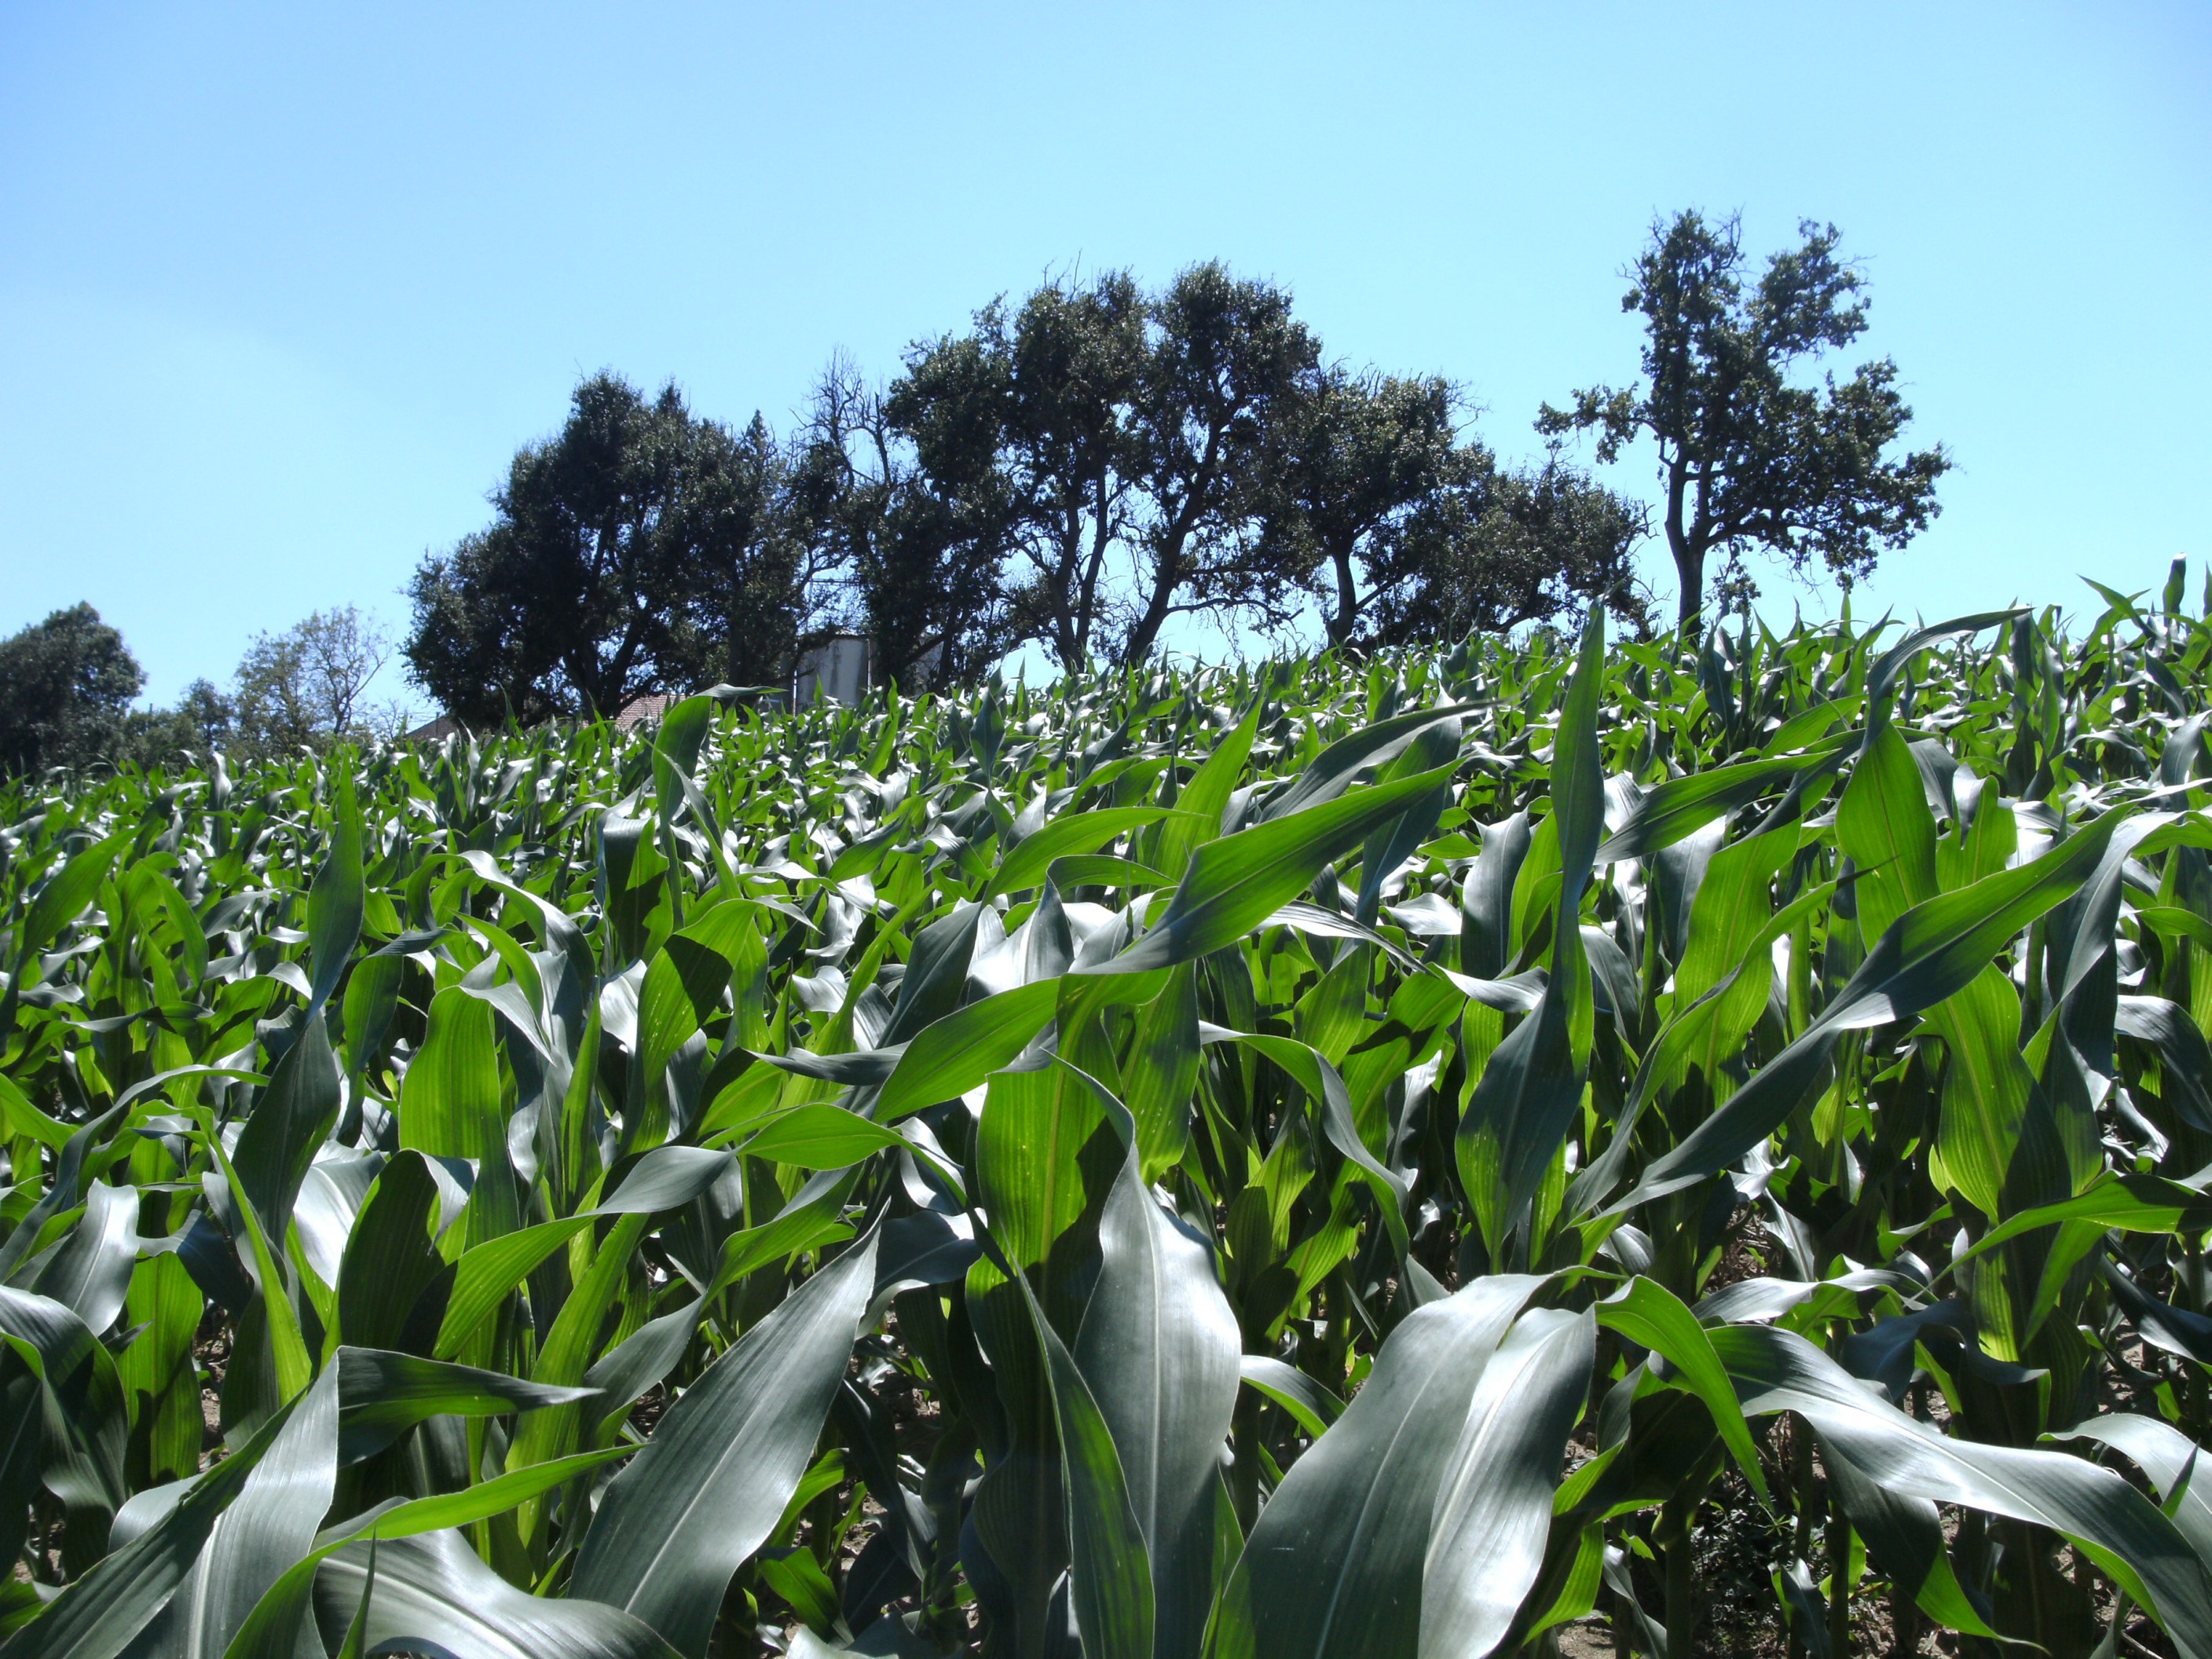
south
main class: Cropland
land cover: Maize
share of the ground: > 75 %
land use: Agriculture (excluding fallow land and kitchen gardens)
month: July
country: AT
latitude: 48.2430
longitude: 13.4061
